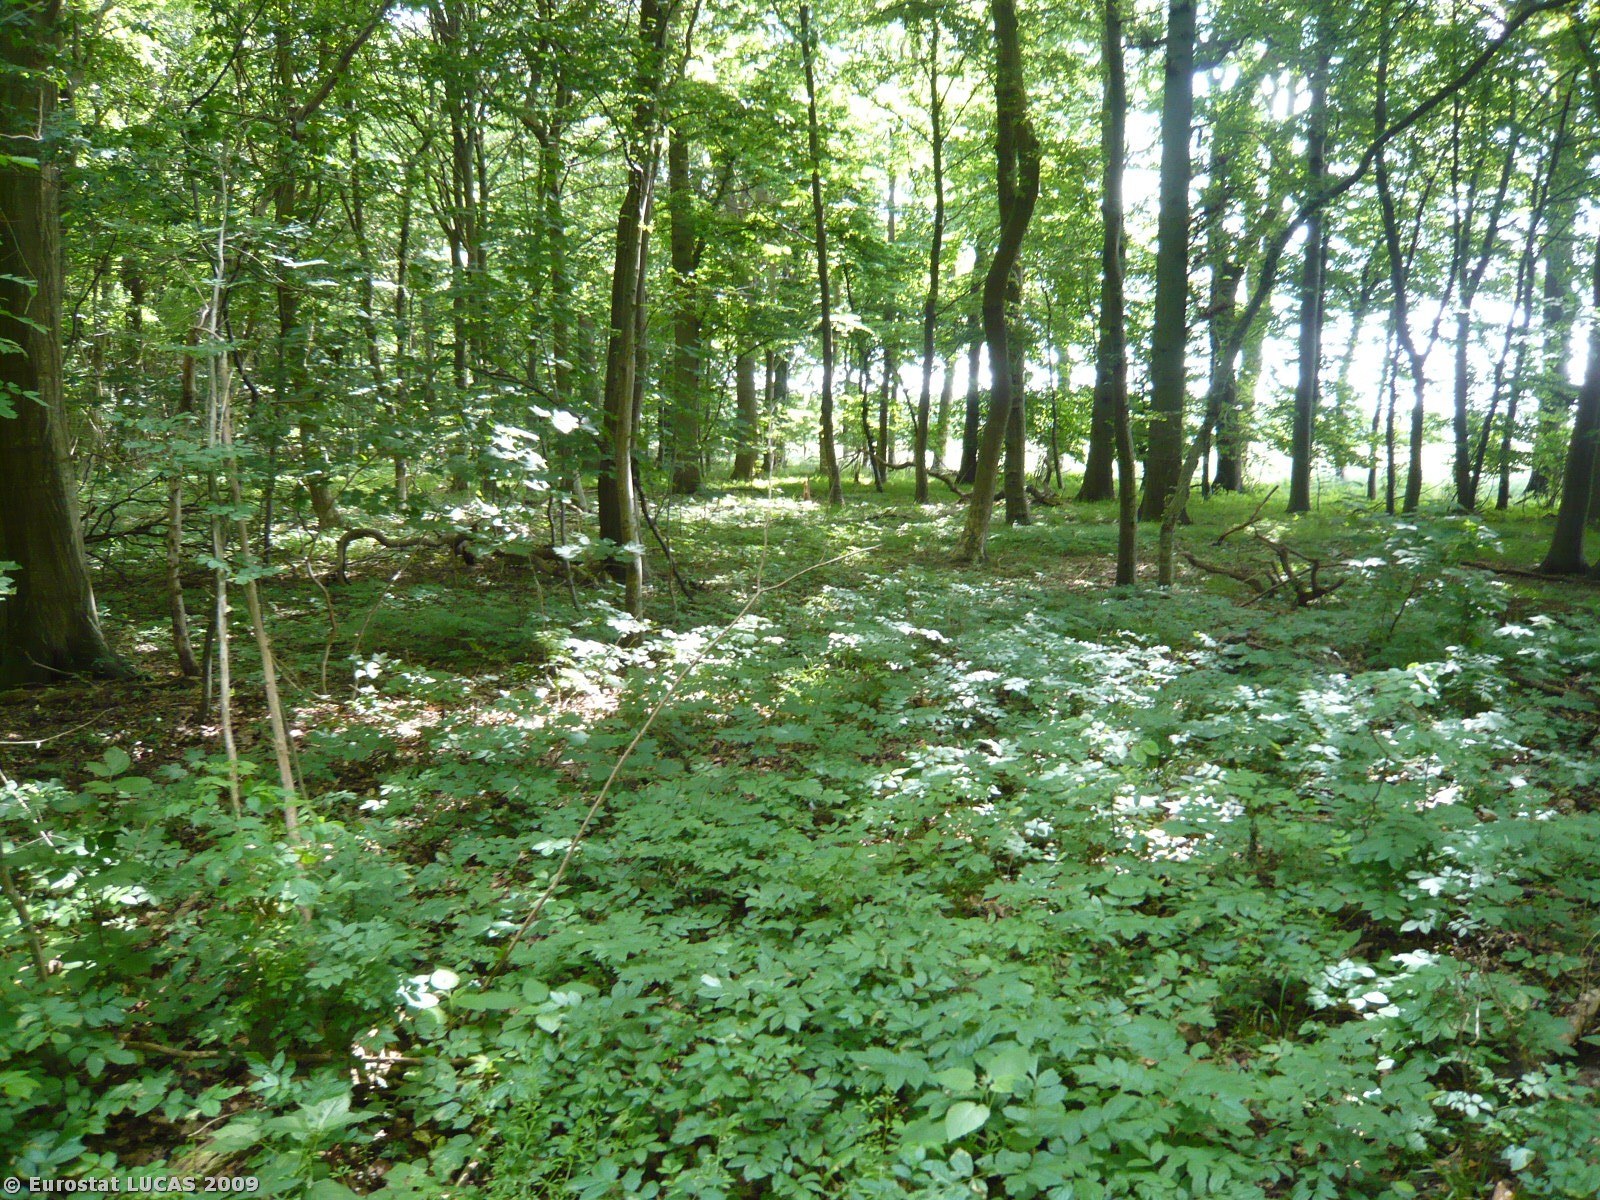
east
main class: Woodland
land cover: Broadleaved woodland
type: mesophytic deciduous forest
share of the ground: > 75 %
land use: Forestry
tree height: > 5 m
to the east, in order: Broadleaved woodland; Common wheat
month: June
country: DK
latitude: 54.7200
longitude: 11.7222
